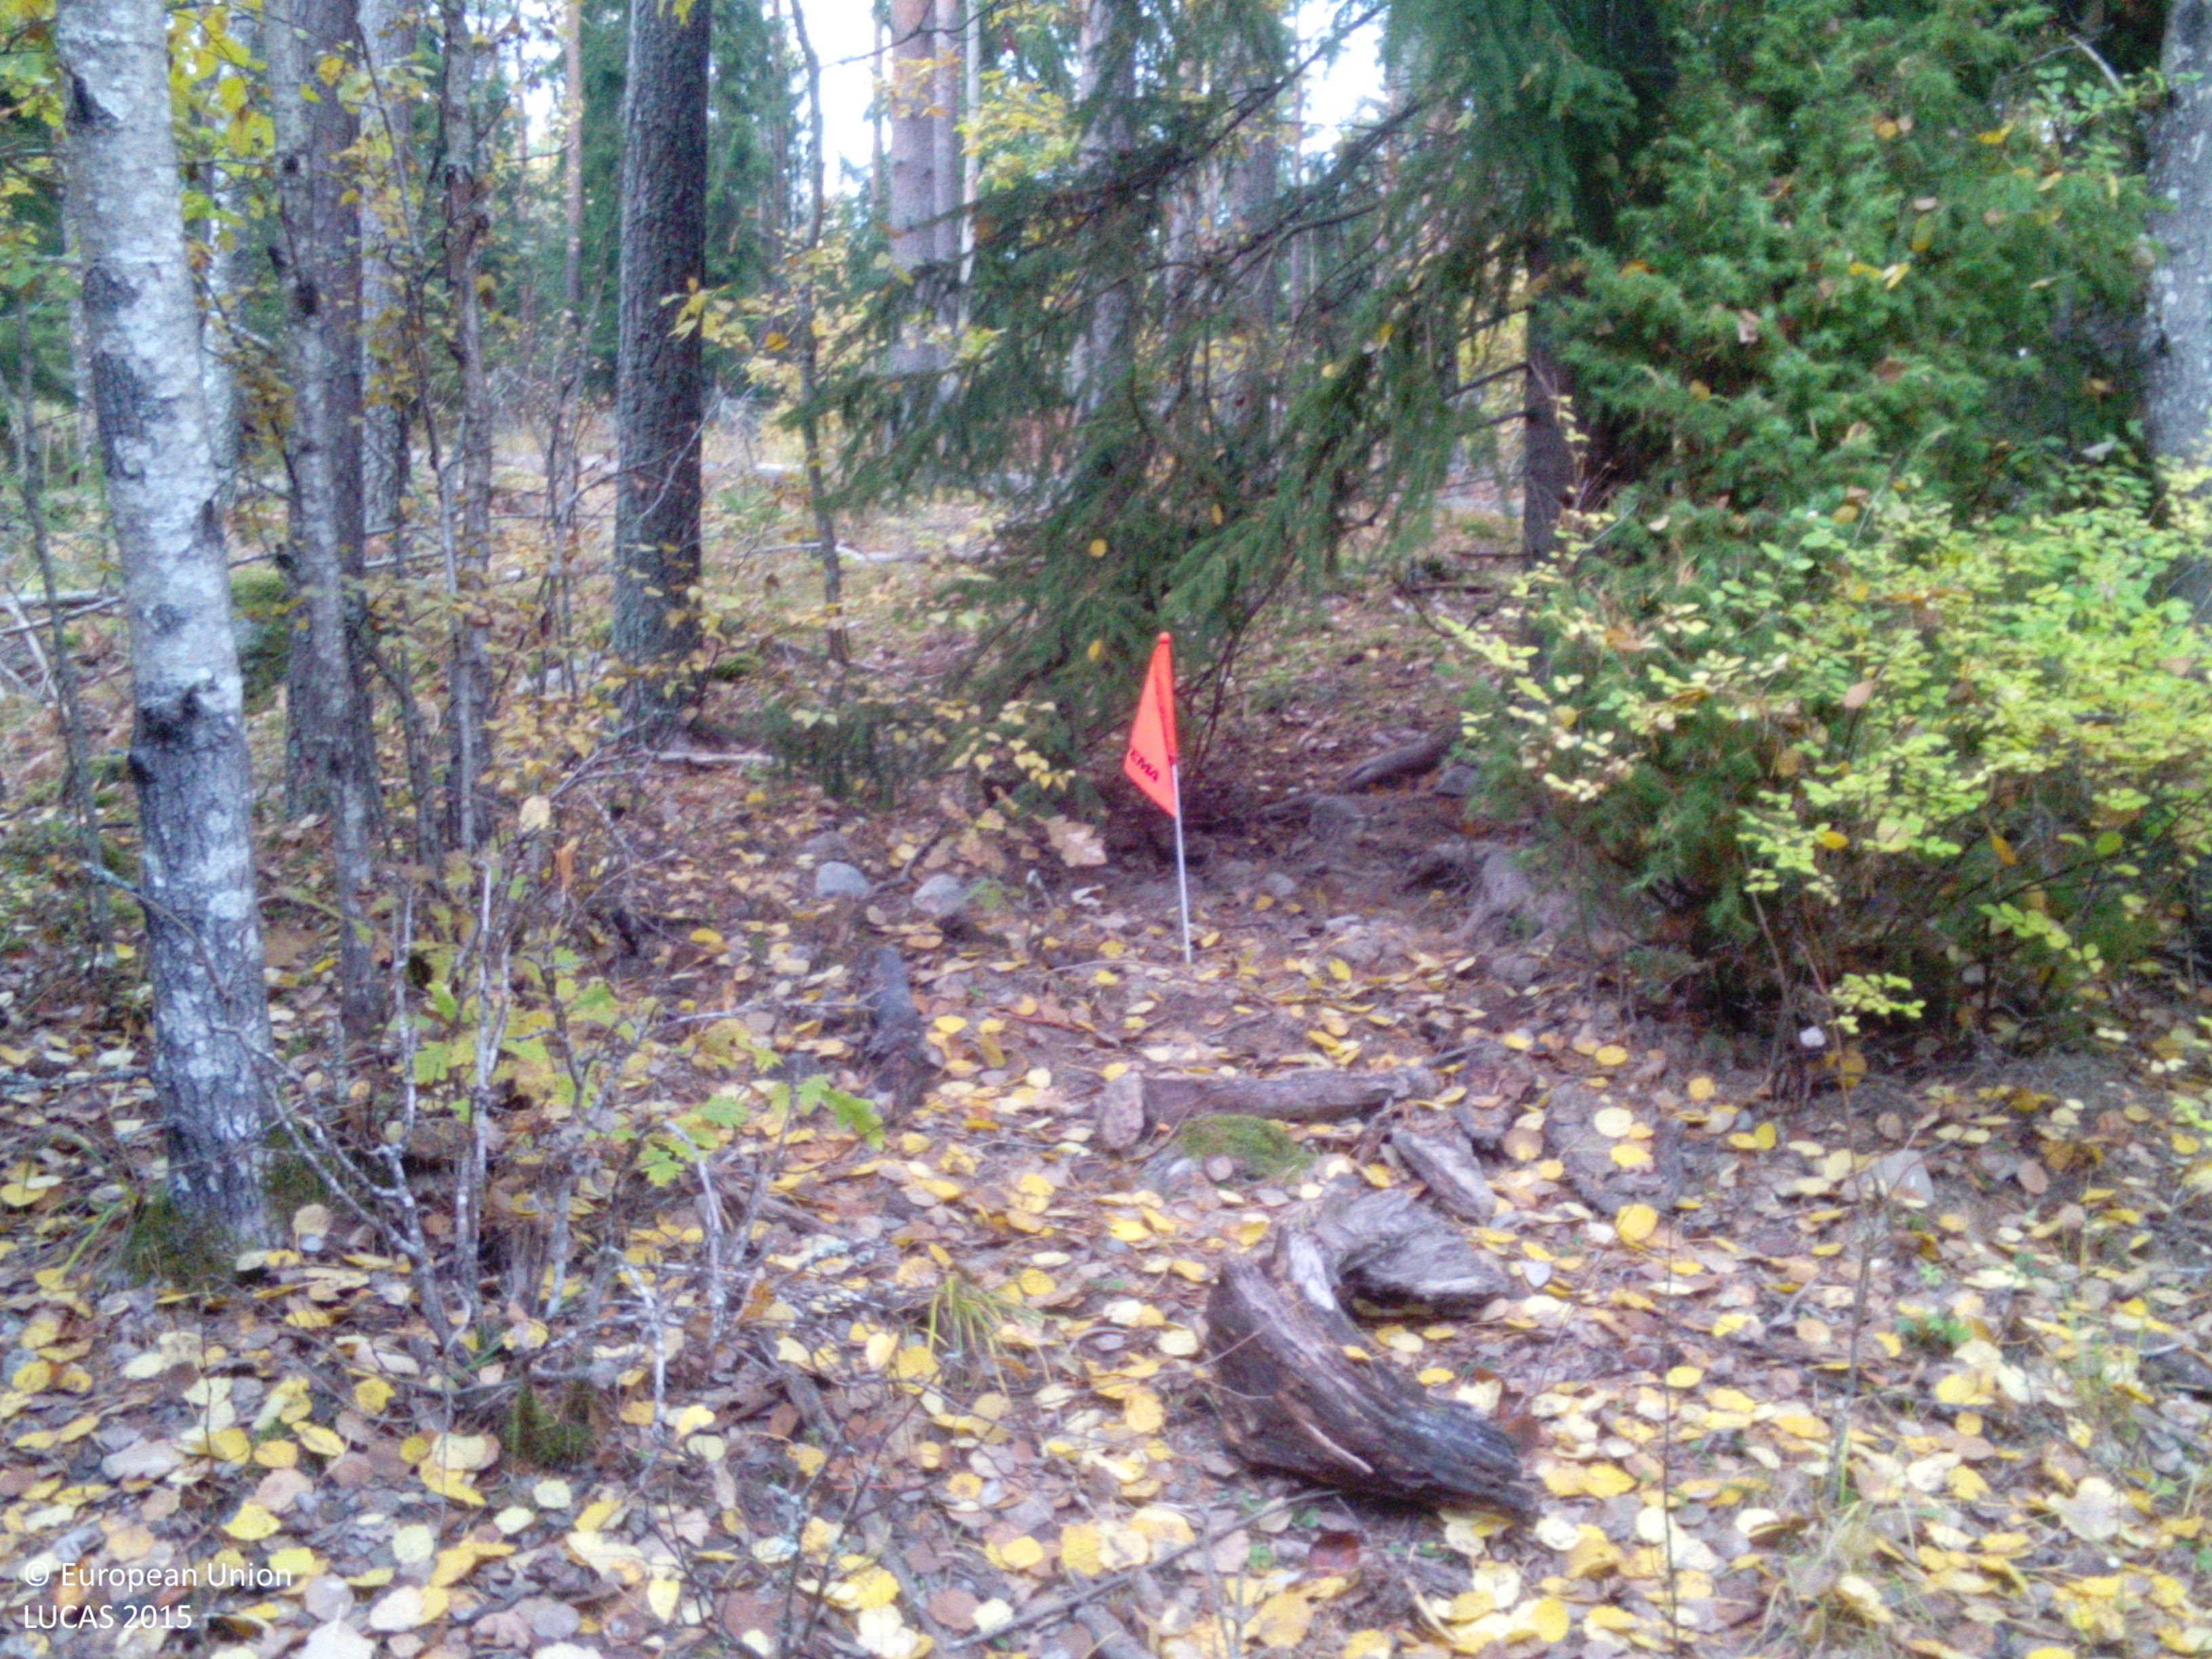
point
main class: Woodland
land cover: Other mixed woodland
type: boreal forest
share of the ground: > 75 %
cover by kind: coniferous forest trees 60 %, broadleaved forest trees 25 %, lichens and mosses 10 %, herbaceous plants 5 %
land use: Forestry
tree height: > 5 m
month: October
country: SE
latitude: 59.2100
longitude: 16.2808
